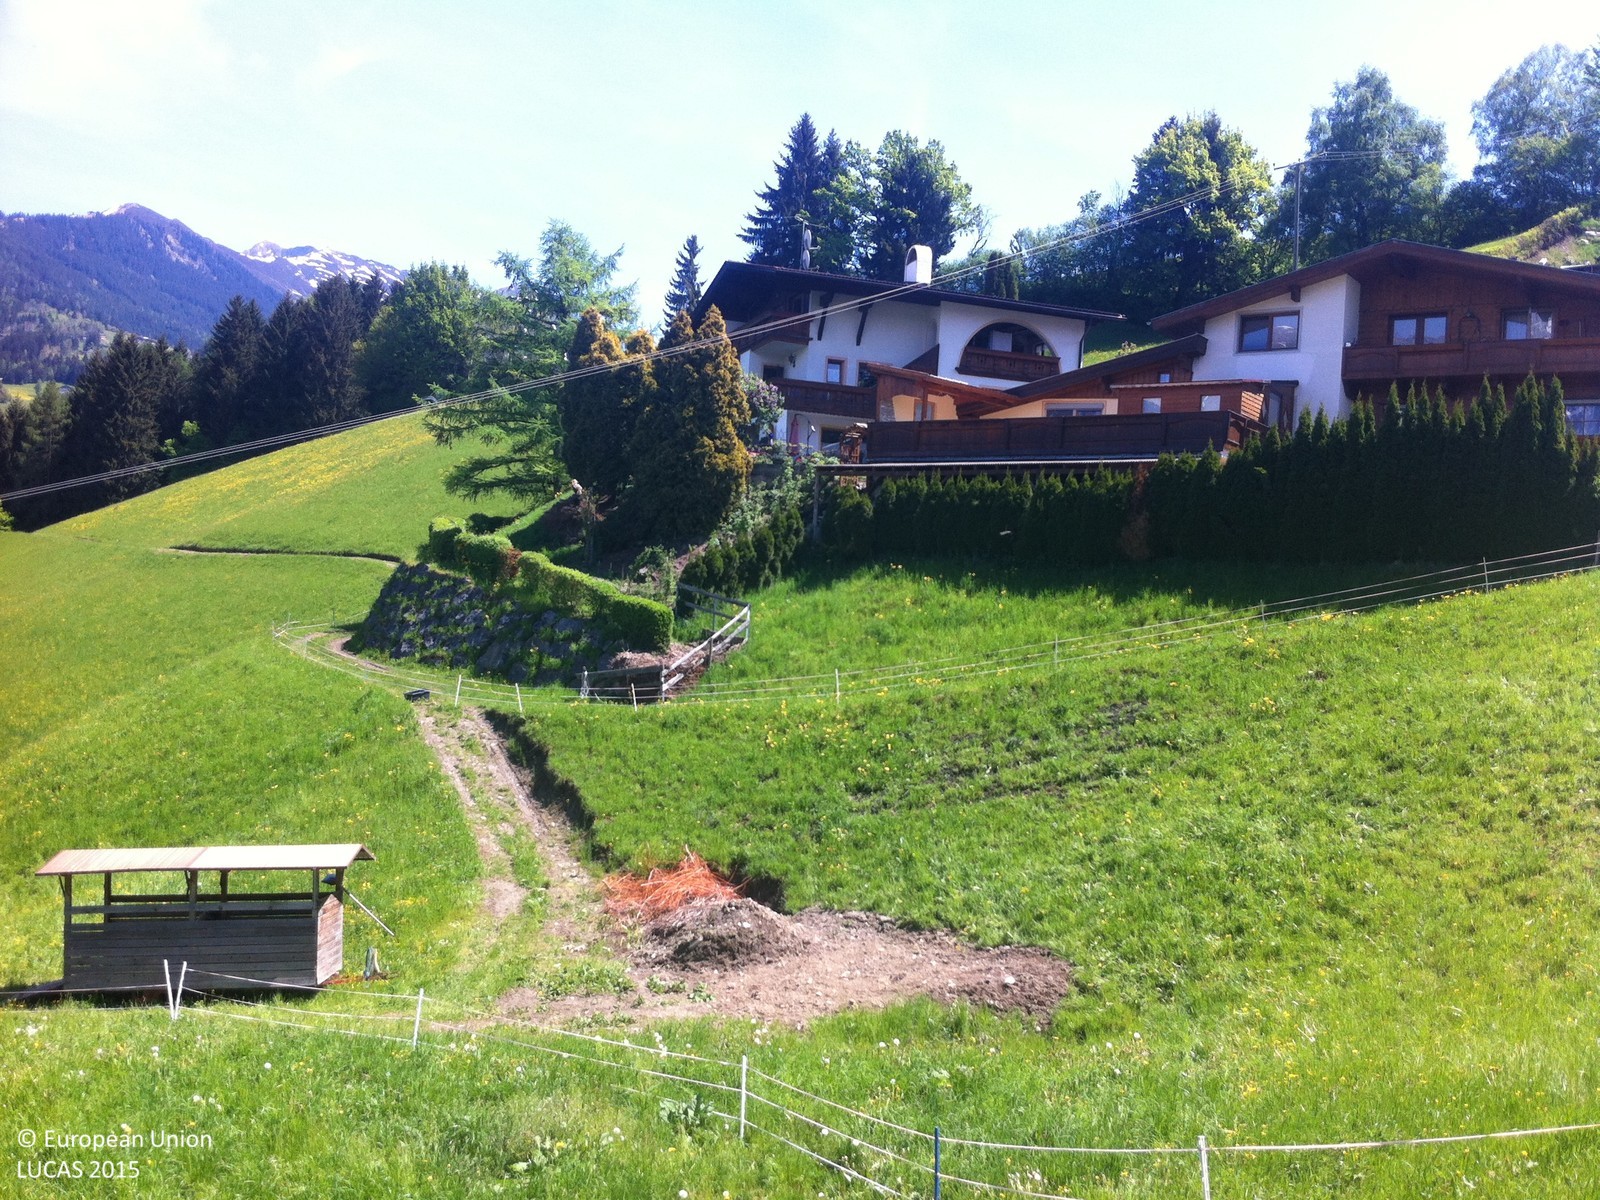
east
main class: Grassland
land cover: Grassland without tree/shrub cover
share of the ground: > 75 %
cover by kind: herbaceous plants 100 %
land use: Agriculture (excluding fallow land and kitchen gardens)
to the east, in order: Grassland without tree/shrub cover; Tracks; Grassland without tree/shrub cover; Fences; Grassland without tree/shrub cover; Tracks; Fences; Tracks; Artificial constructions in urban areas; Electric lines; Artificial constructions in urban areas; Grassland without tree/shrub cover; Tracks; Broadleaved woodland; Fences; Broadleaved woodland; Tracks; Grassland without tree/shrub cover; Tracks
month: May
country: AT
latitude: 47.3106
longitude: 11.6785
